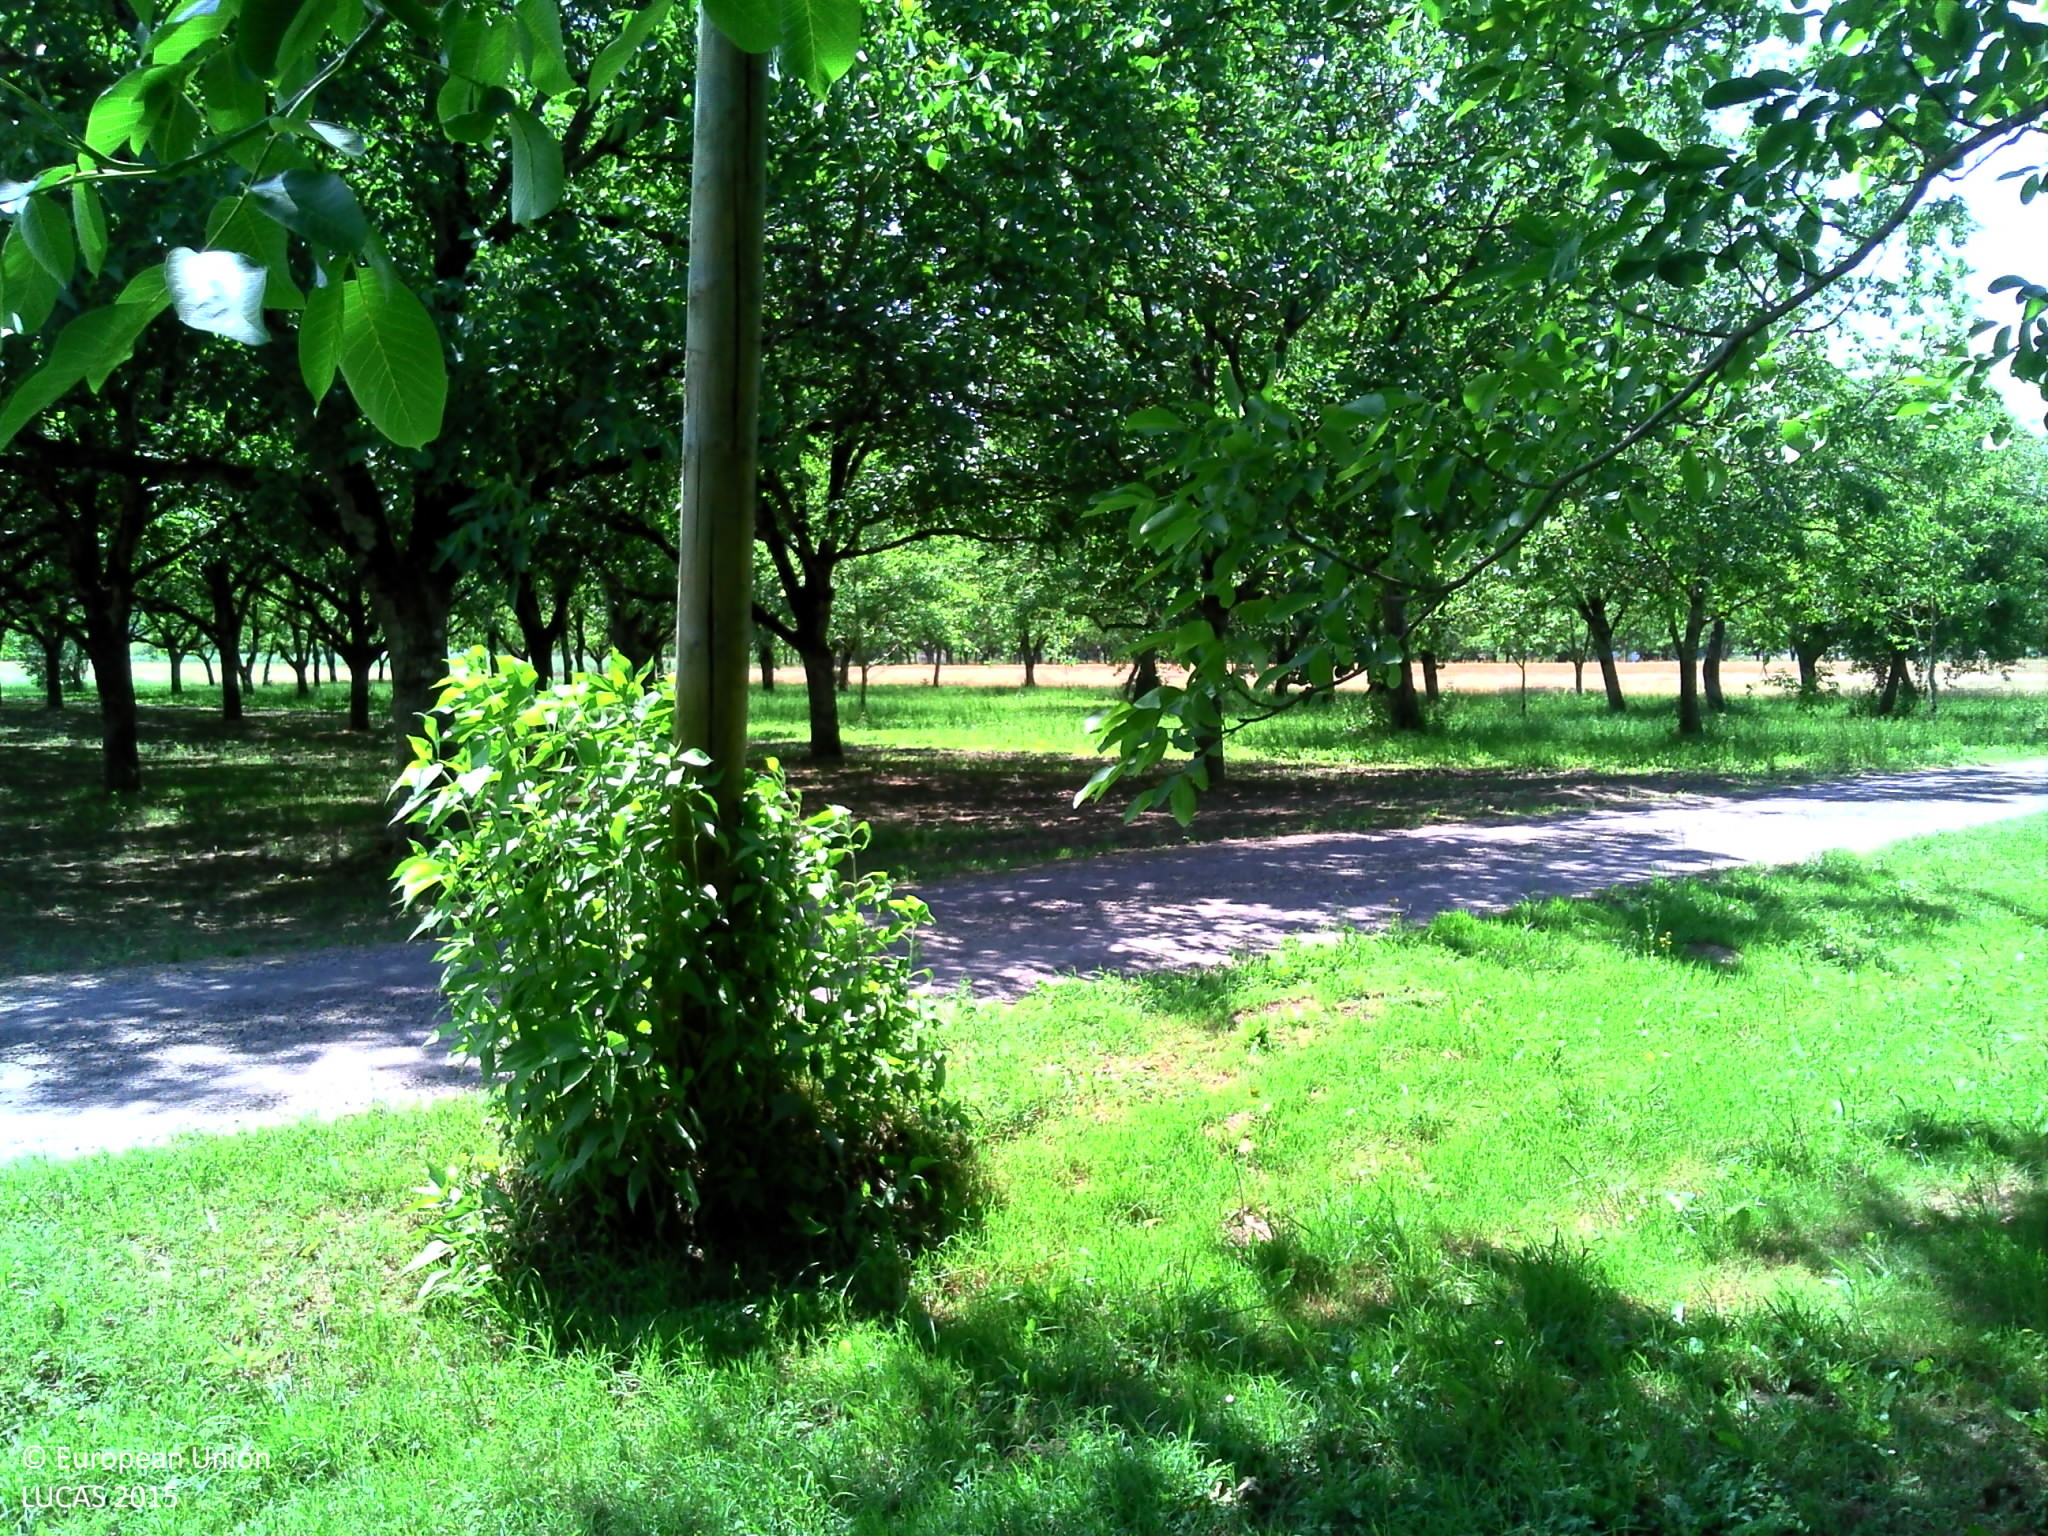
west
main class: Cropland
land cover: Nuts trees
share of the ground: 50 - 75 %
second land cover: Grassland without tree/shrub cover
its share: 10 - 25 %
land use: Agriculture (excluding fallow land and kitchen gardens)
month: June
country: FR
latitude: 44.9275
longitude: 1.7494
